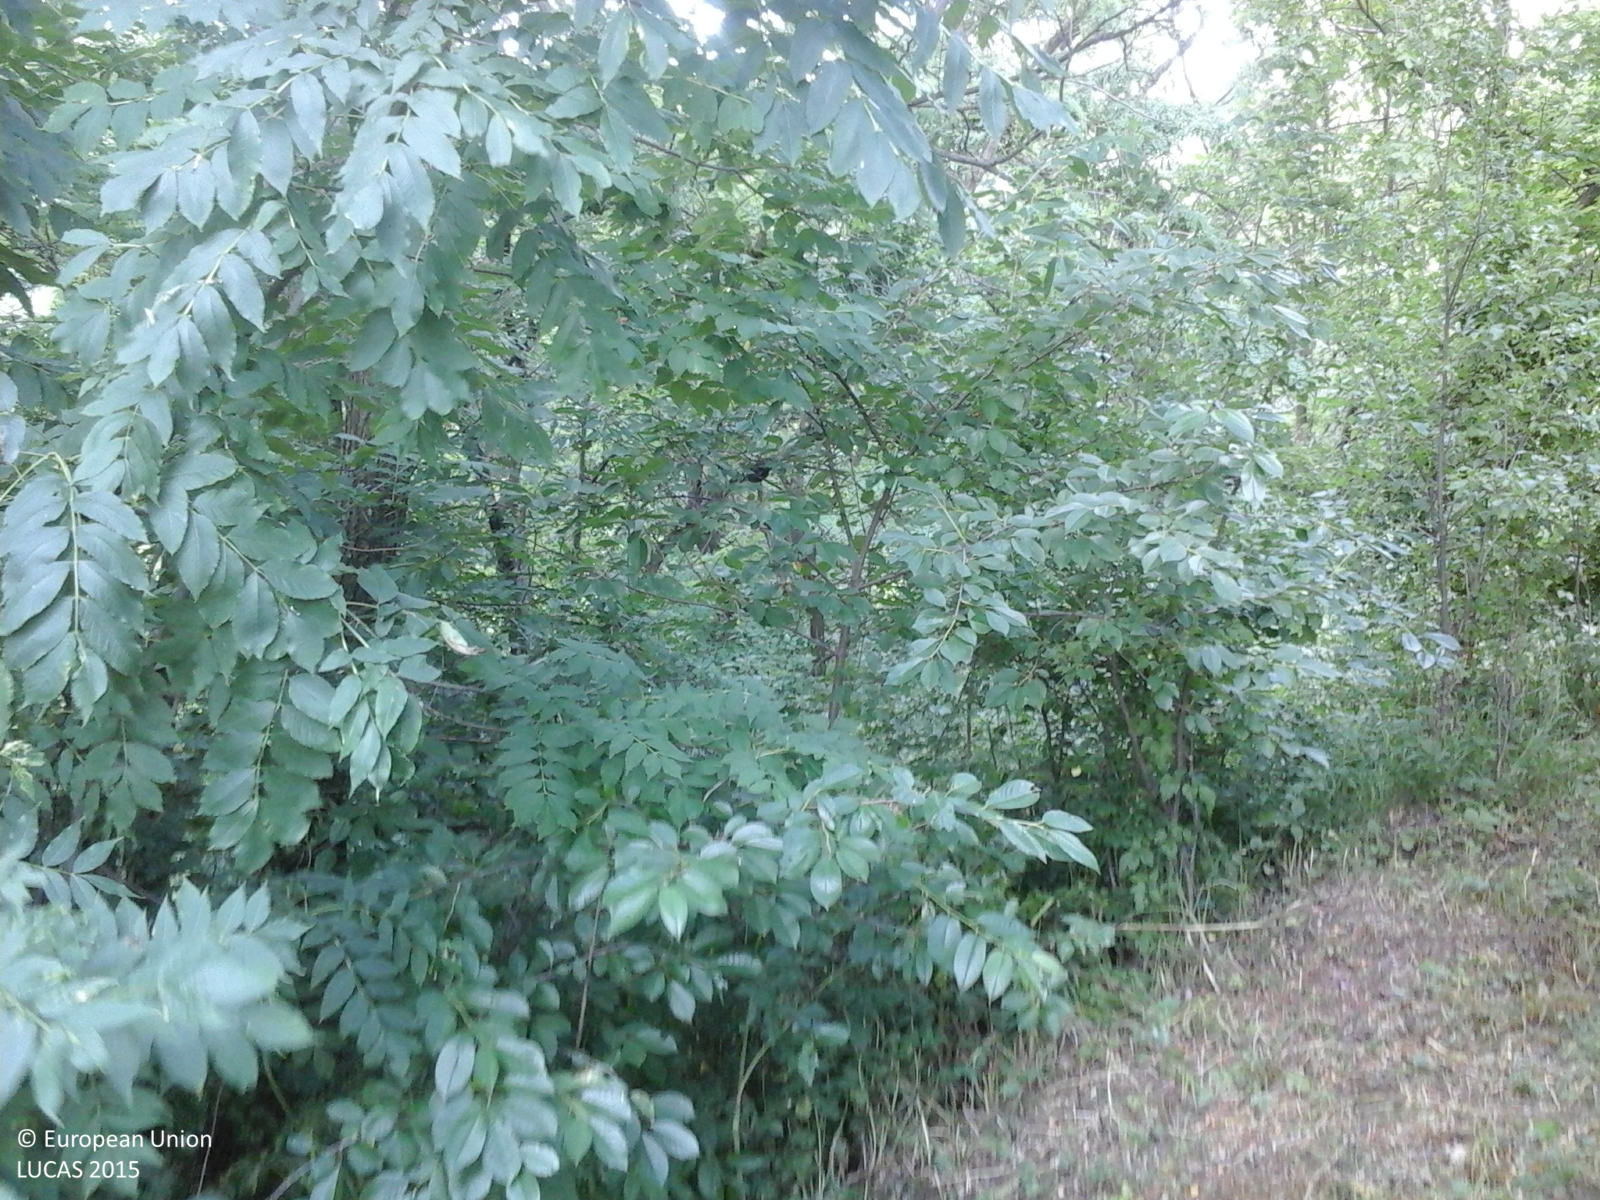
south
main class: Woodland
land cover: Broadleaved woodland
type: exotic forest
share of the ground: > 75 %
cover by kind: broadleaved forest trees 100 %
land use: Forestry
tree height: > 5 m
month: June
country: RO
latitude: 47.1052
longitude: 26.3288
